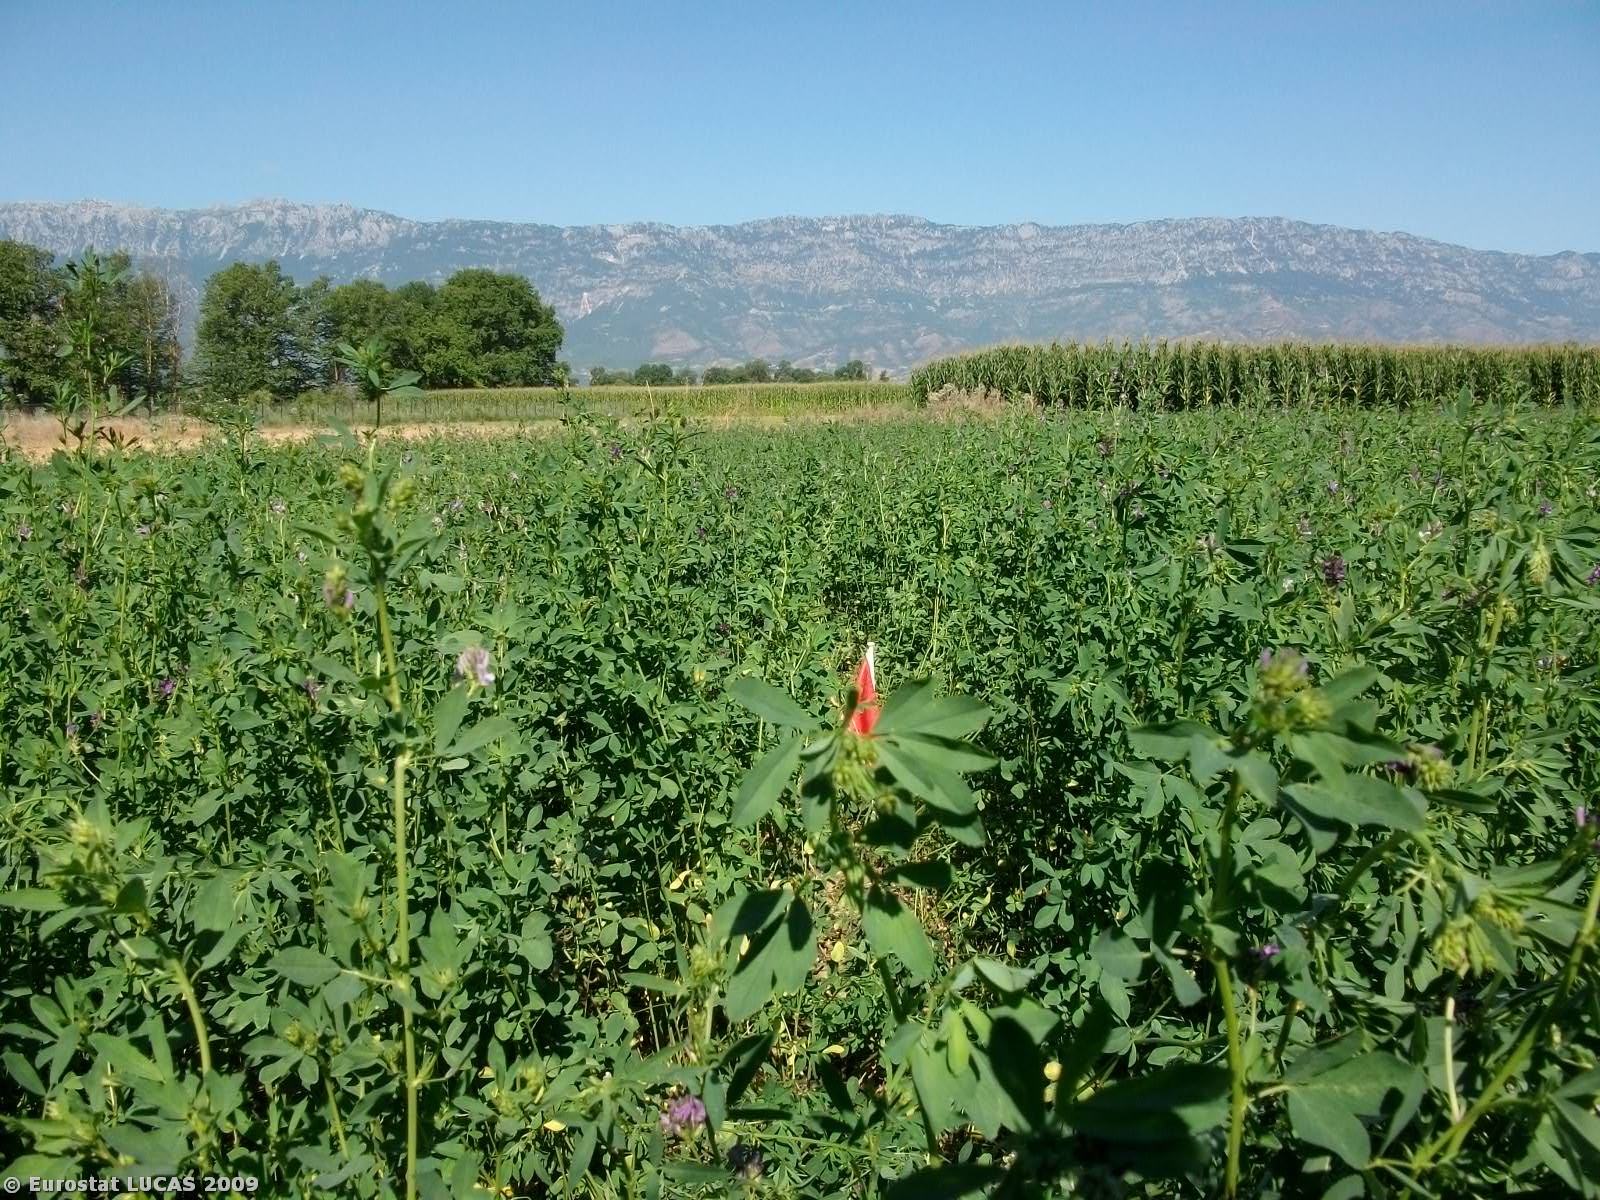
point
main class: Cropland
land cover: Clovers
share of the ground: > 75 %
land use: Agriculture (excluding fallow land and kitchen gardens)
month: July
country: GR
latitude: 39.5670
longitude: 21.6811
